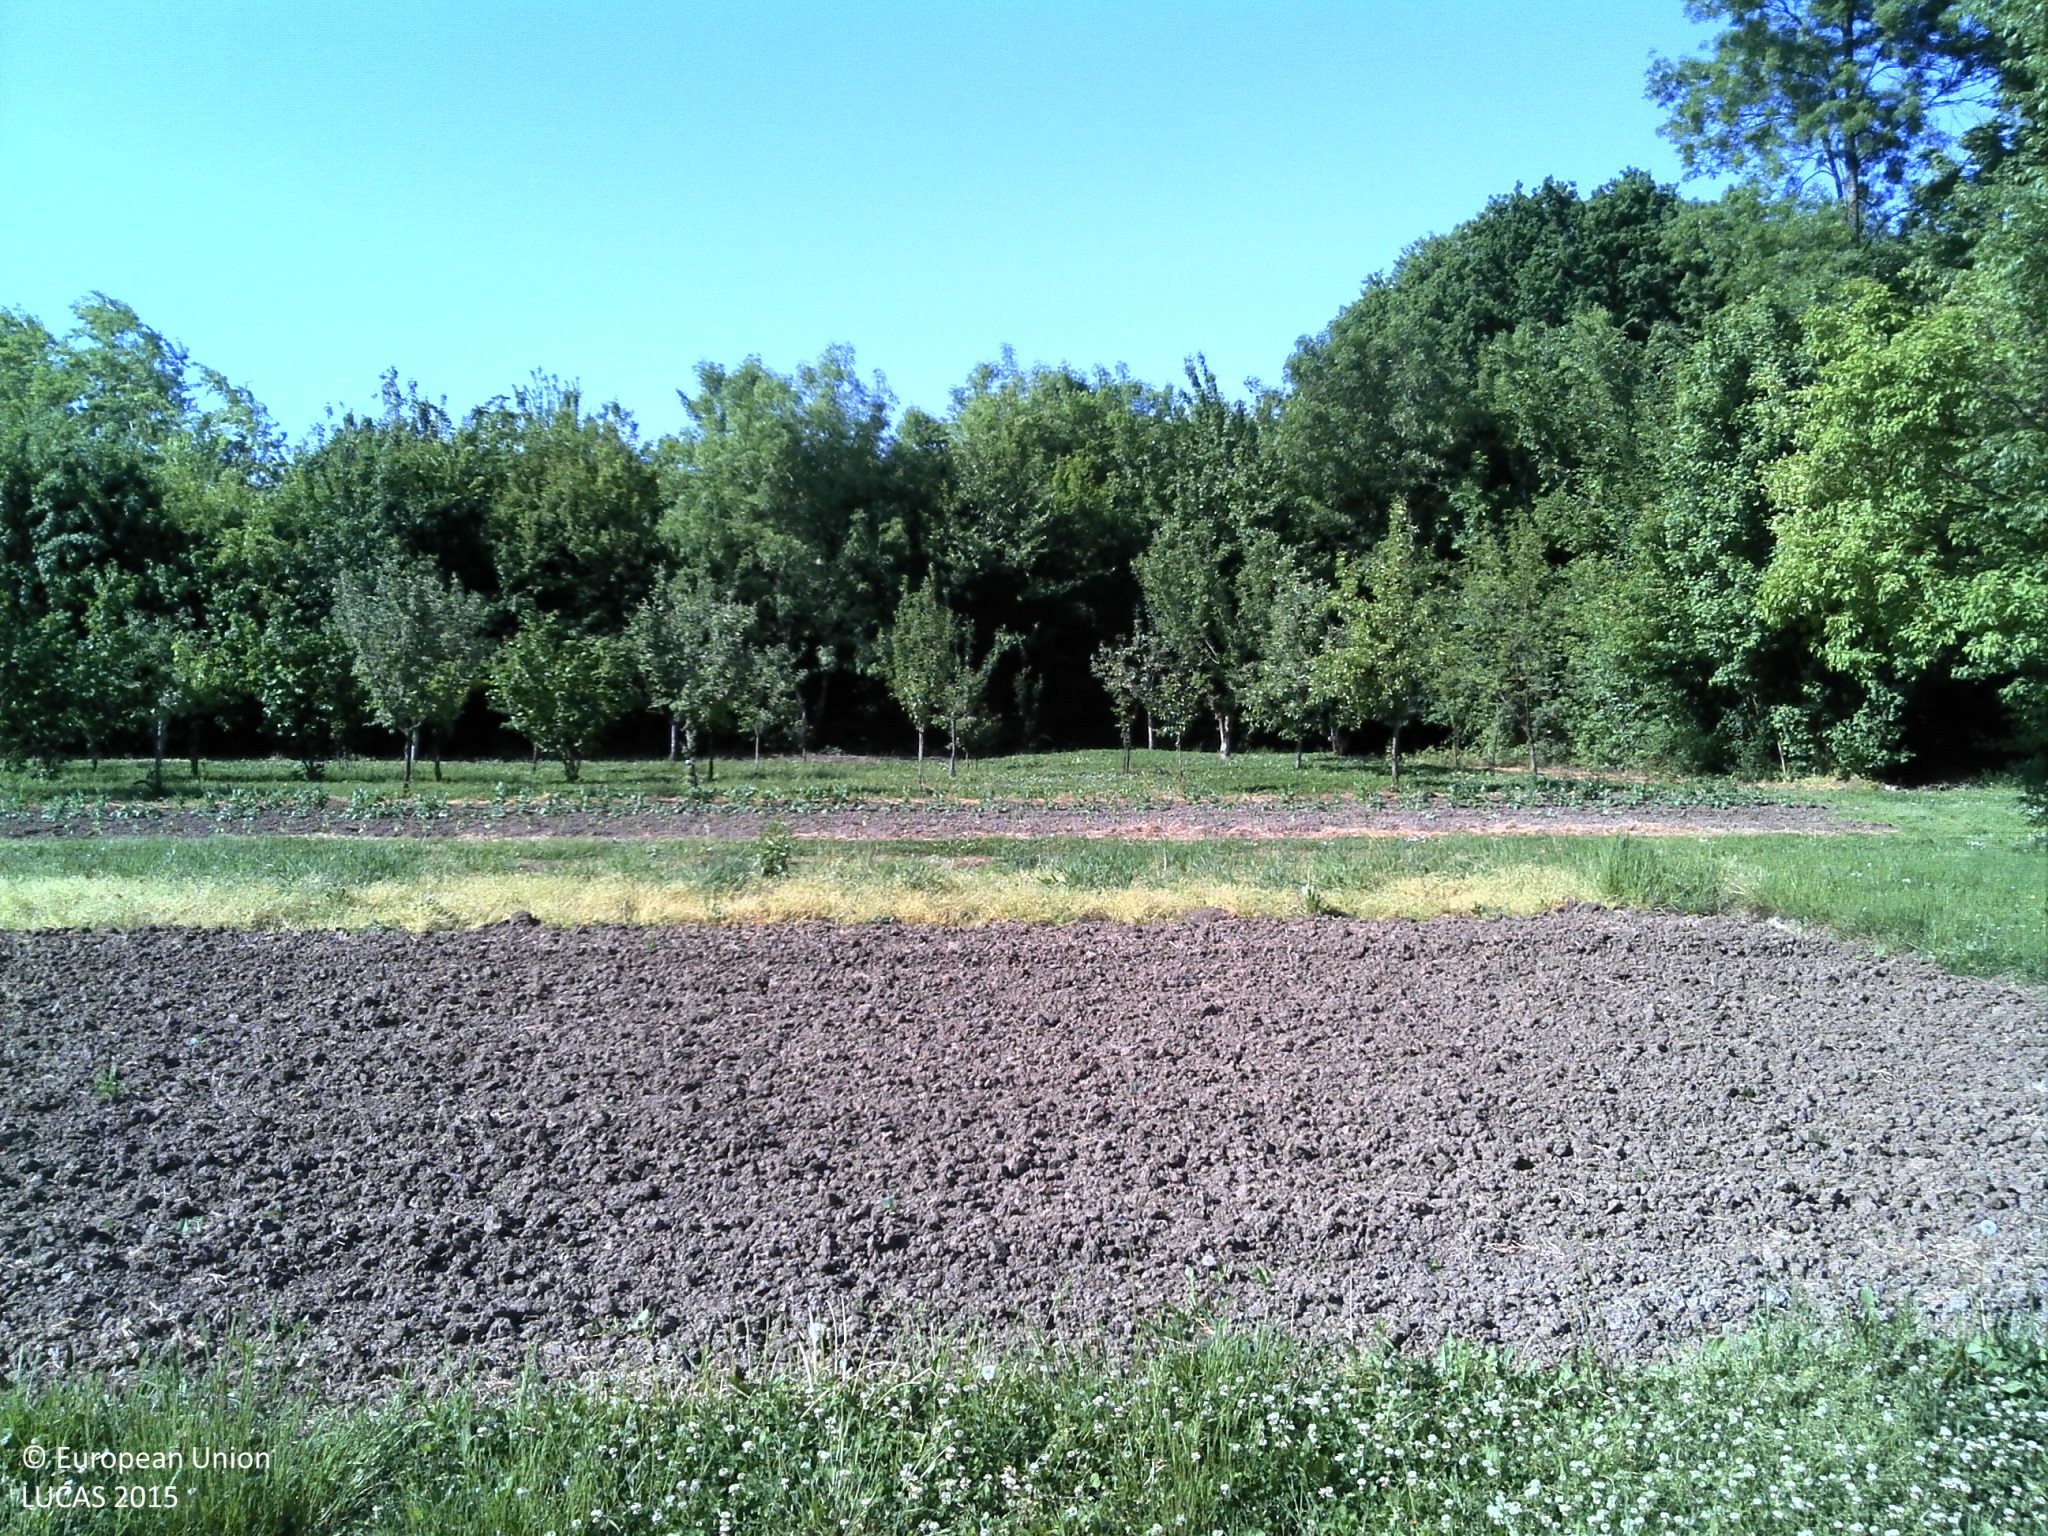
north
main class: Grassland
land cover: Spontaneously vegetated surfaces
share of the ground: < 10 %
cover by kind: unconsolidated bare surface 90 %, herbaceous plants 10 %
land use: Fallow land
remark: Harvested field
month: May
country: HR
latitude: 45.1522
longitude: 18.1563
